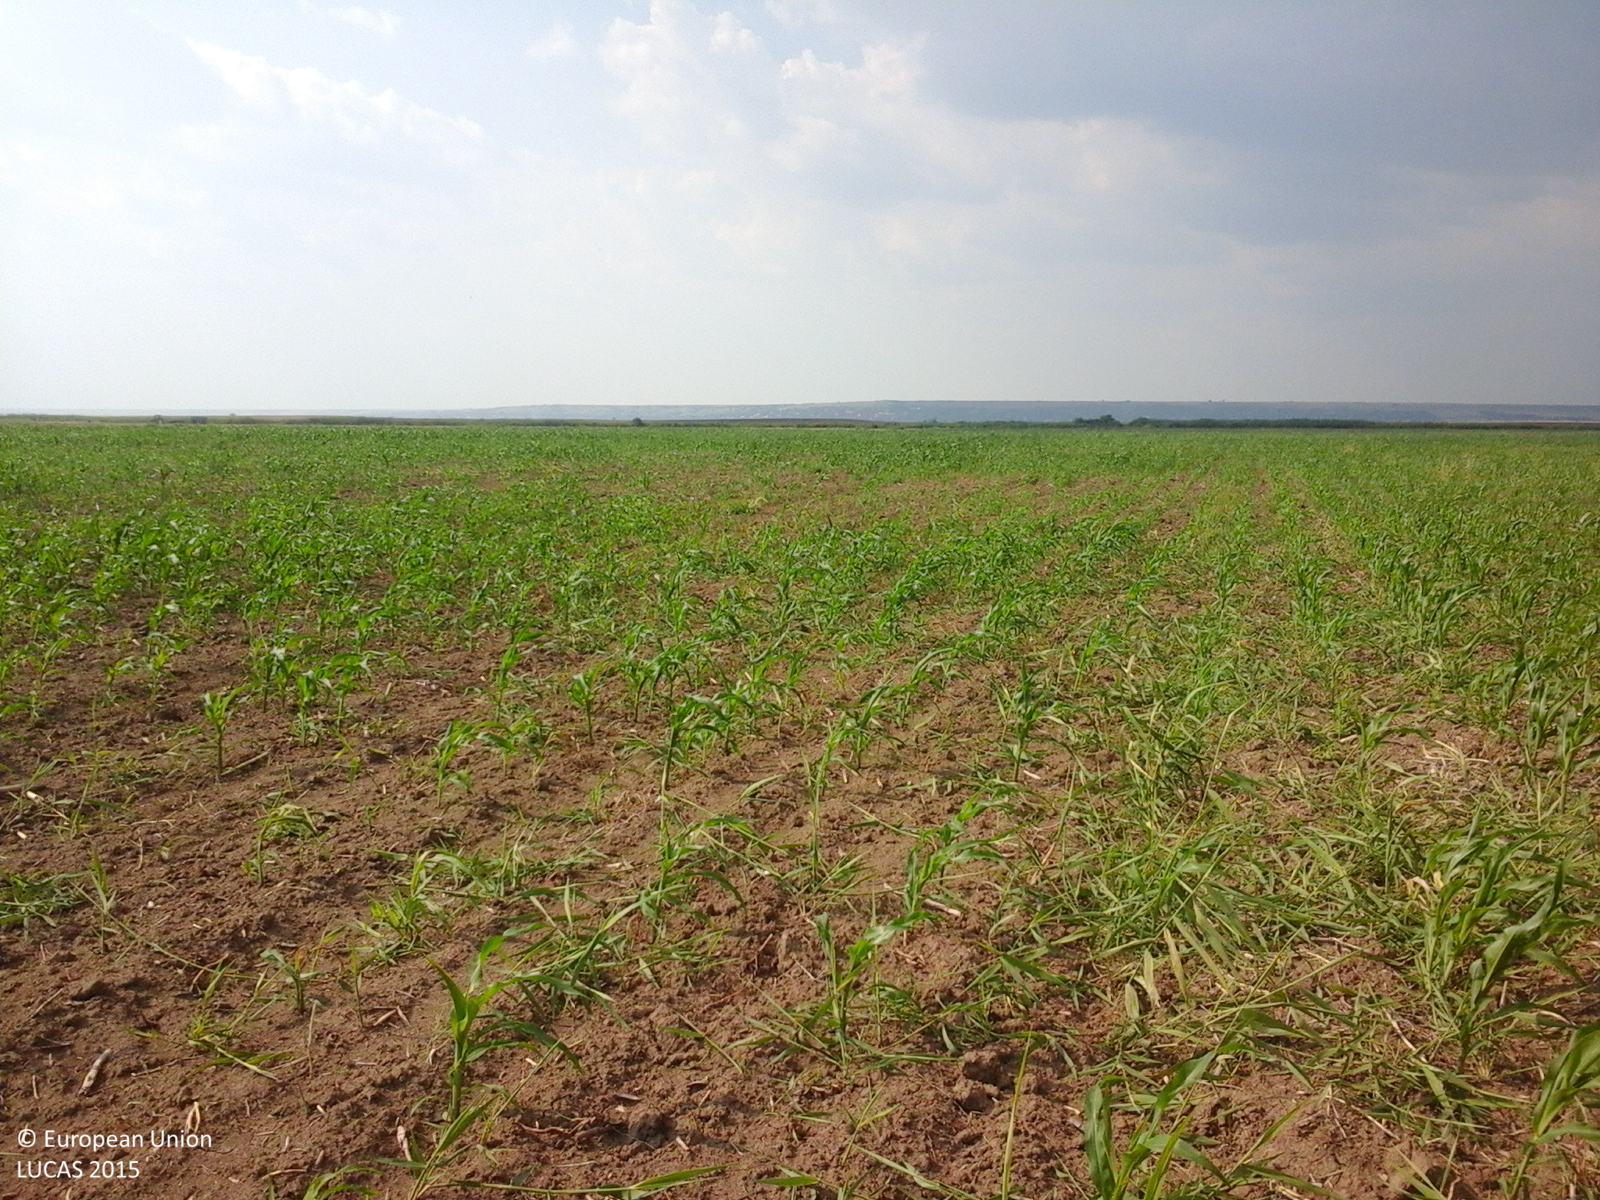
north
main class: Cropland
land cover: Maize
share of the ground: 10 - 25 %
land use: Agriculture (excluding fallow land and kitchen gardens)
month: July
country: RO
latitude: 43.6960
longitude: 25.1010
